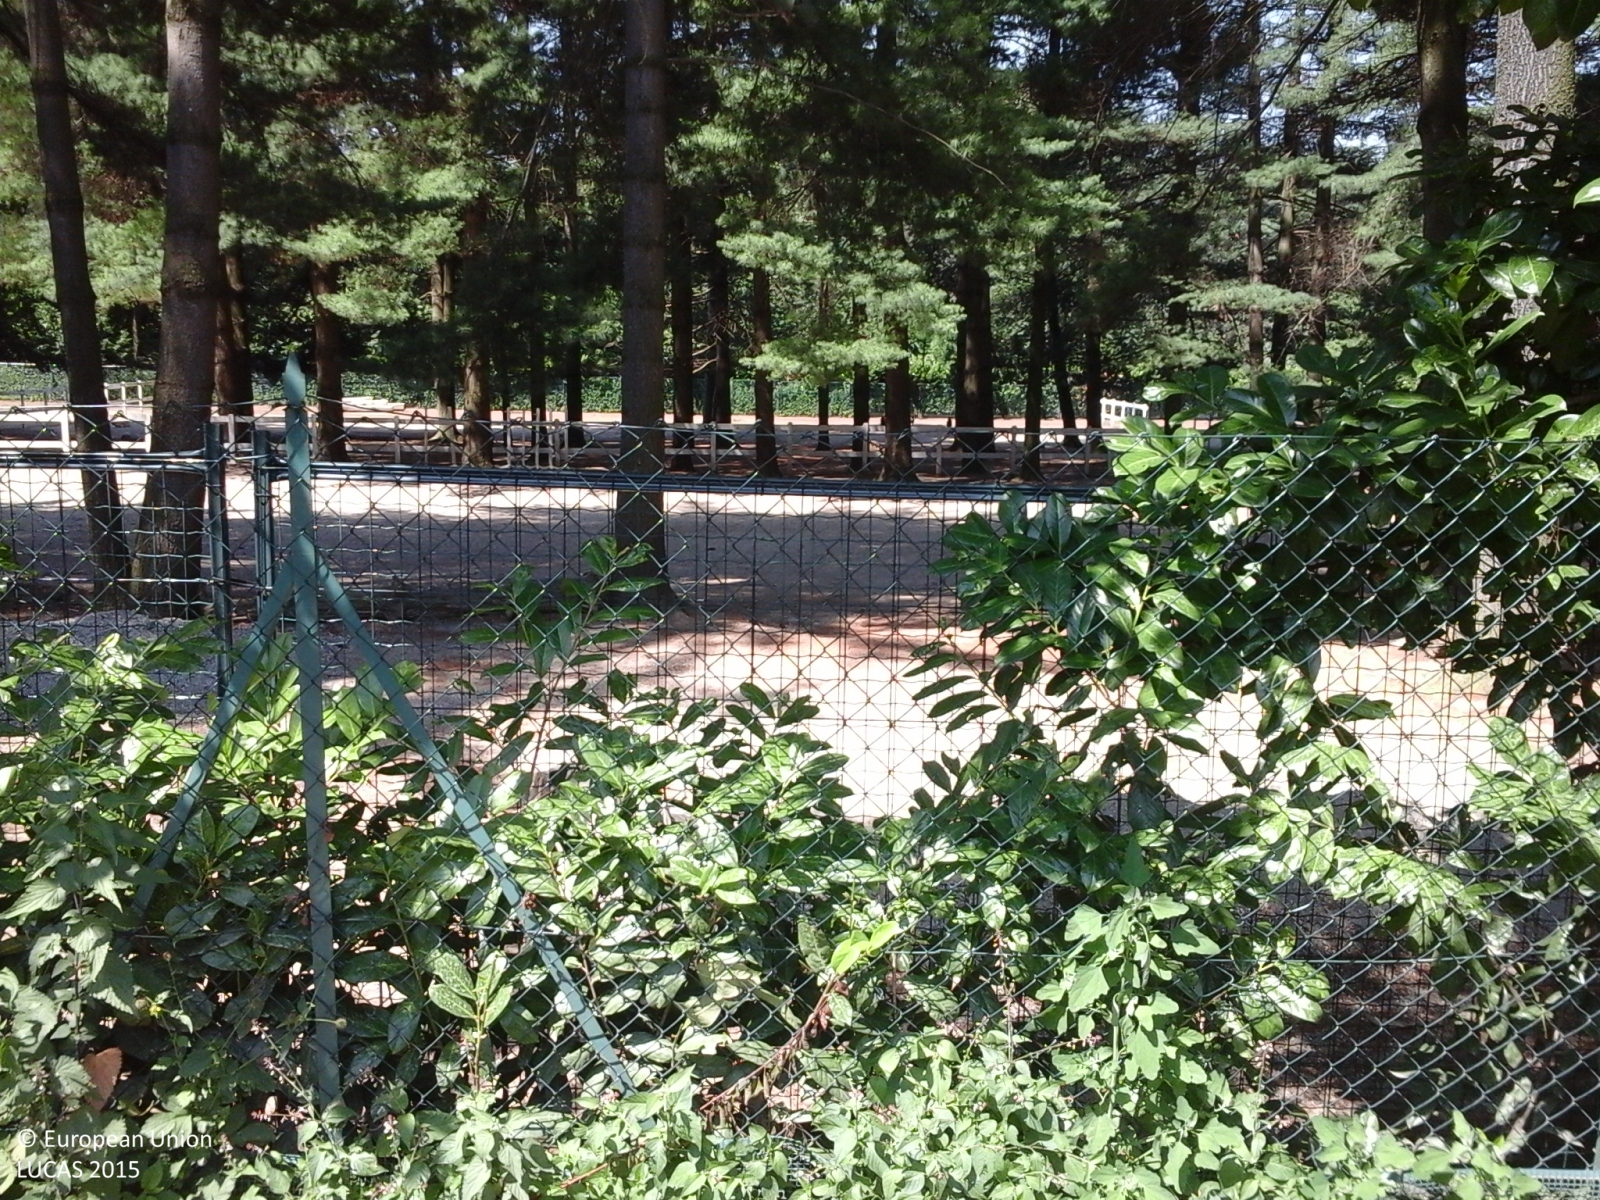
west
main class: Woodland
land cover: Pine dominated coniferous woodland
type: coniferous forest of the mediterranean region
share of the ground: > 75 %
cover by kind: coniferous forest trees 90 %, unconsolidated bare surface 10 %
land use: Amenities, museums, leisure
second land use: Sport
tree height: > 5 m
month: June
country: IT
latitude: 45.6770
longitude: 8.7311
